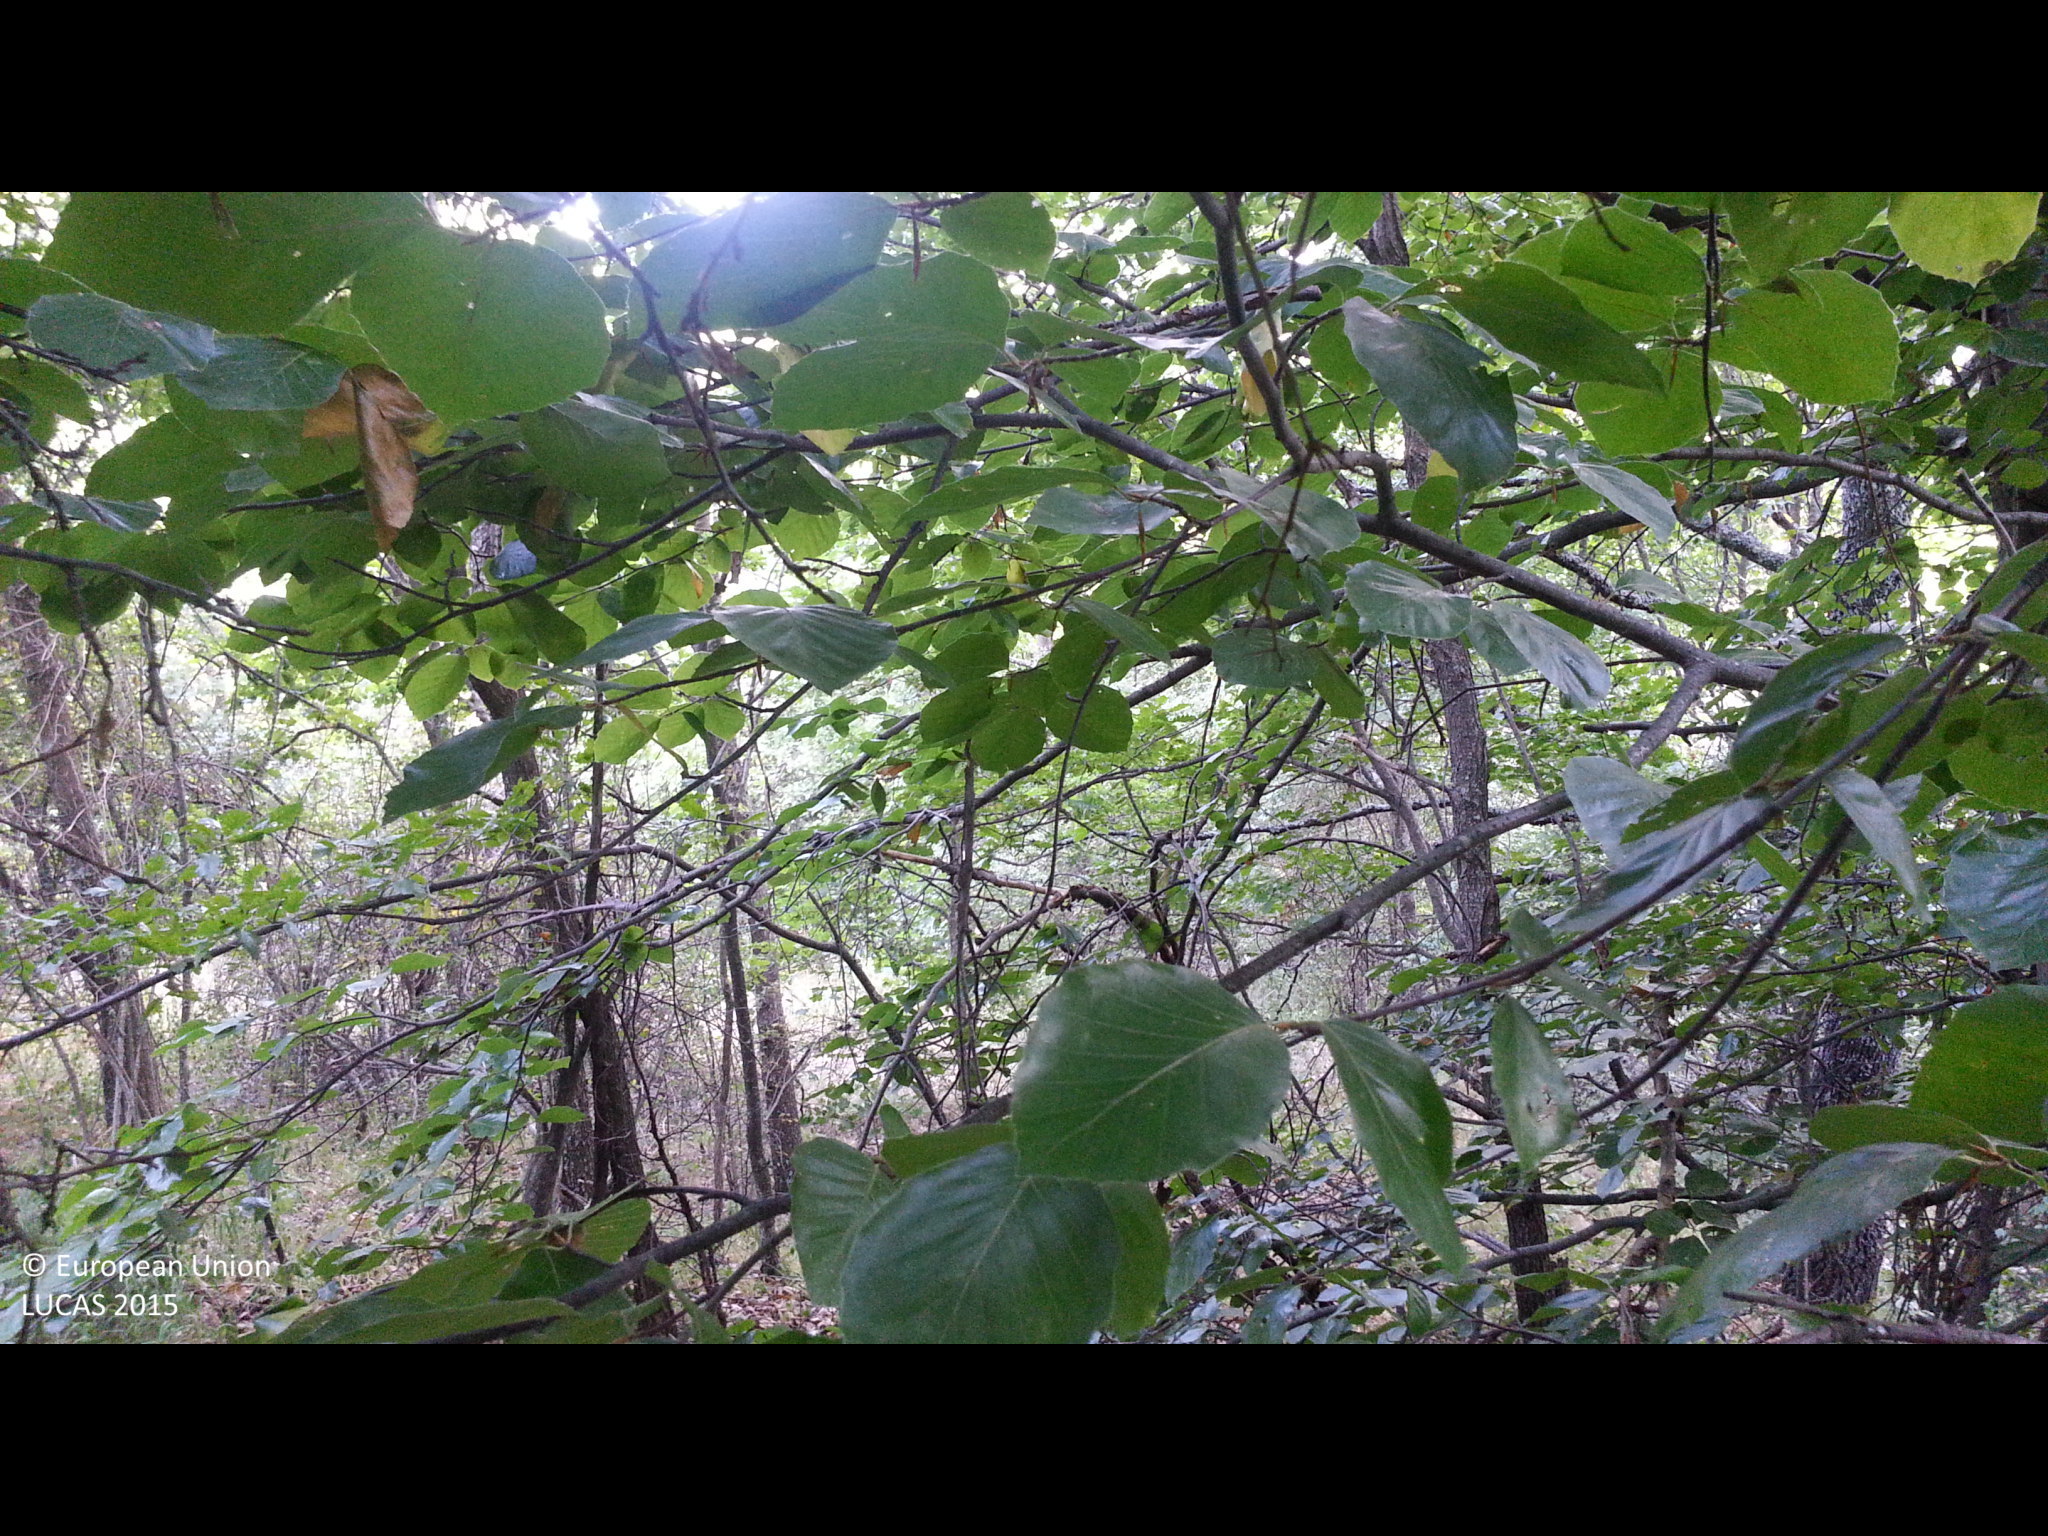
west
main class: Woodland
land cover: Broadleaved woodland
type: mesophytic deciduous forest
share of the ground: > 75 %
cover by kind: broadleaved forest trees 85 %, herbaceous plants 10 %, shrubs 5 %
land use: Forestry
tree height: > 5 m
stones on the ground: < 10 %
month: September
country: BG
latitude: 42.3287
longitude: 22.5319
